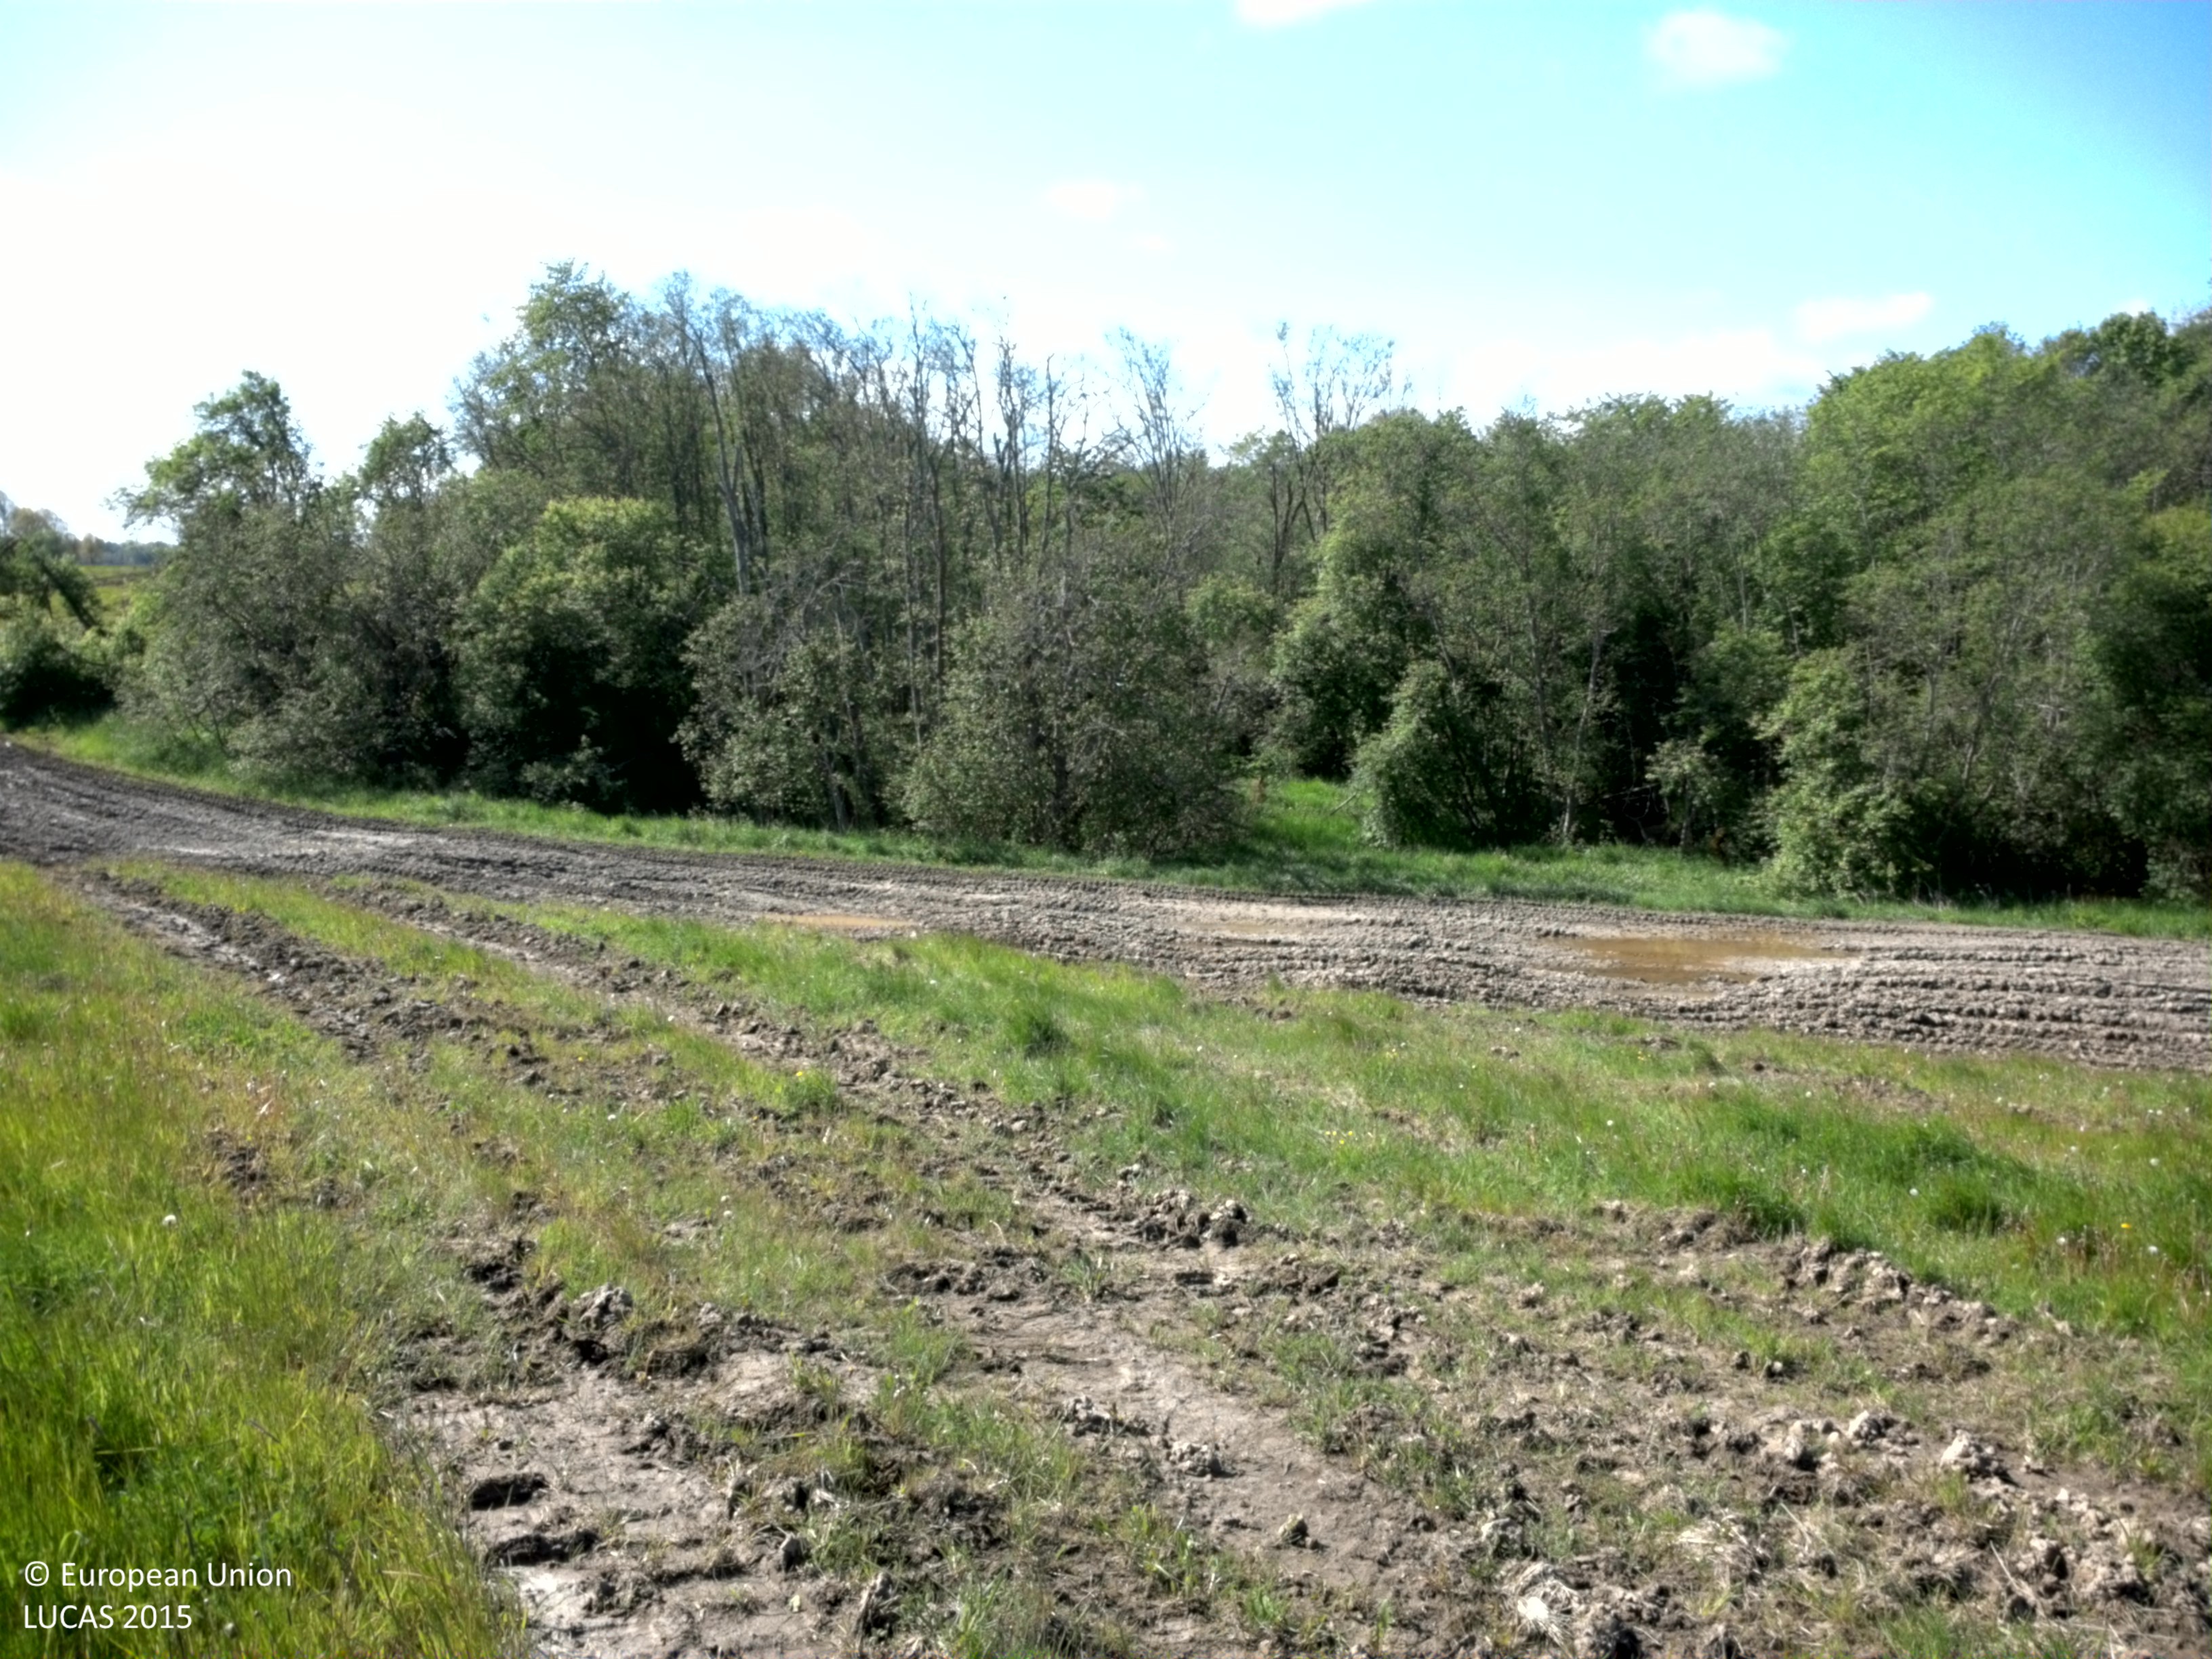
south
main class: Grassland
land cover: Grassland without tree/shrub cover
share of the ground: > 75 %
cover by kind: herbaceous plants 100 %
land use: Community services
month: June
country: SE
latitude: 58.3429
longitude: 13.9059
